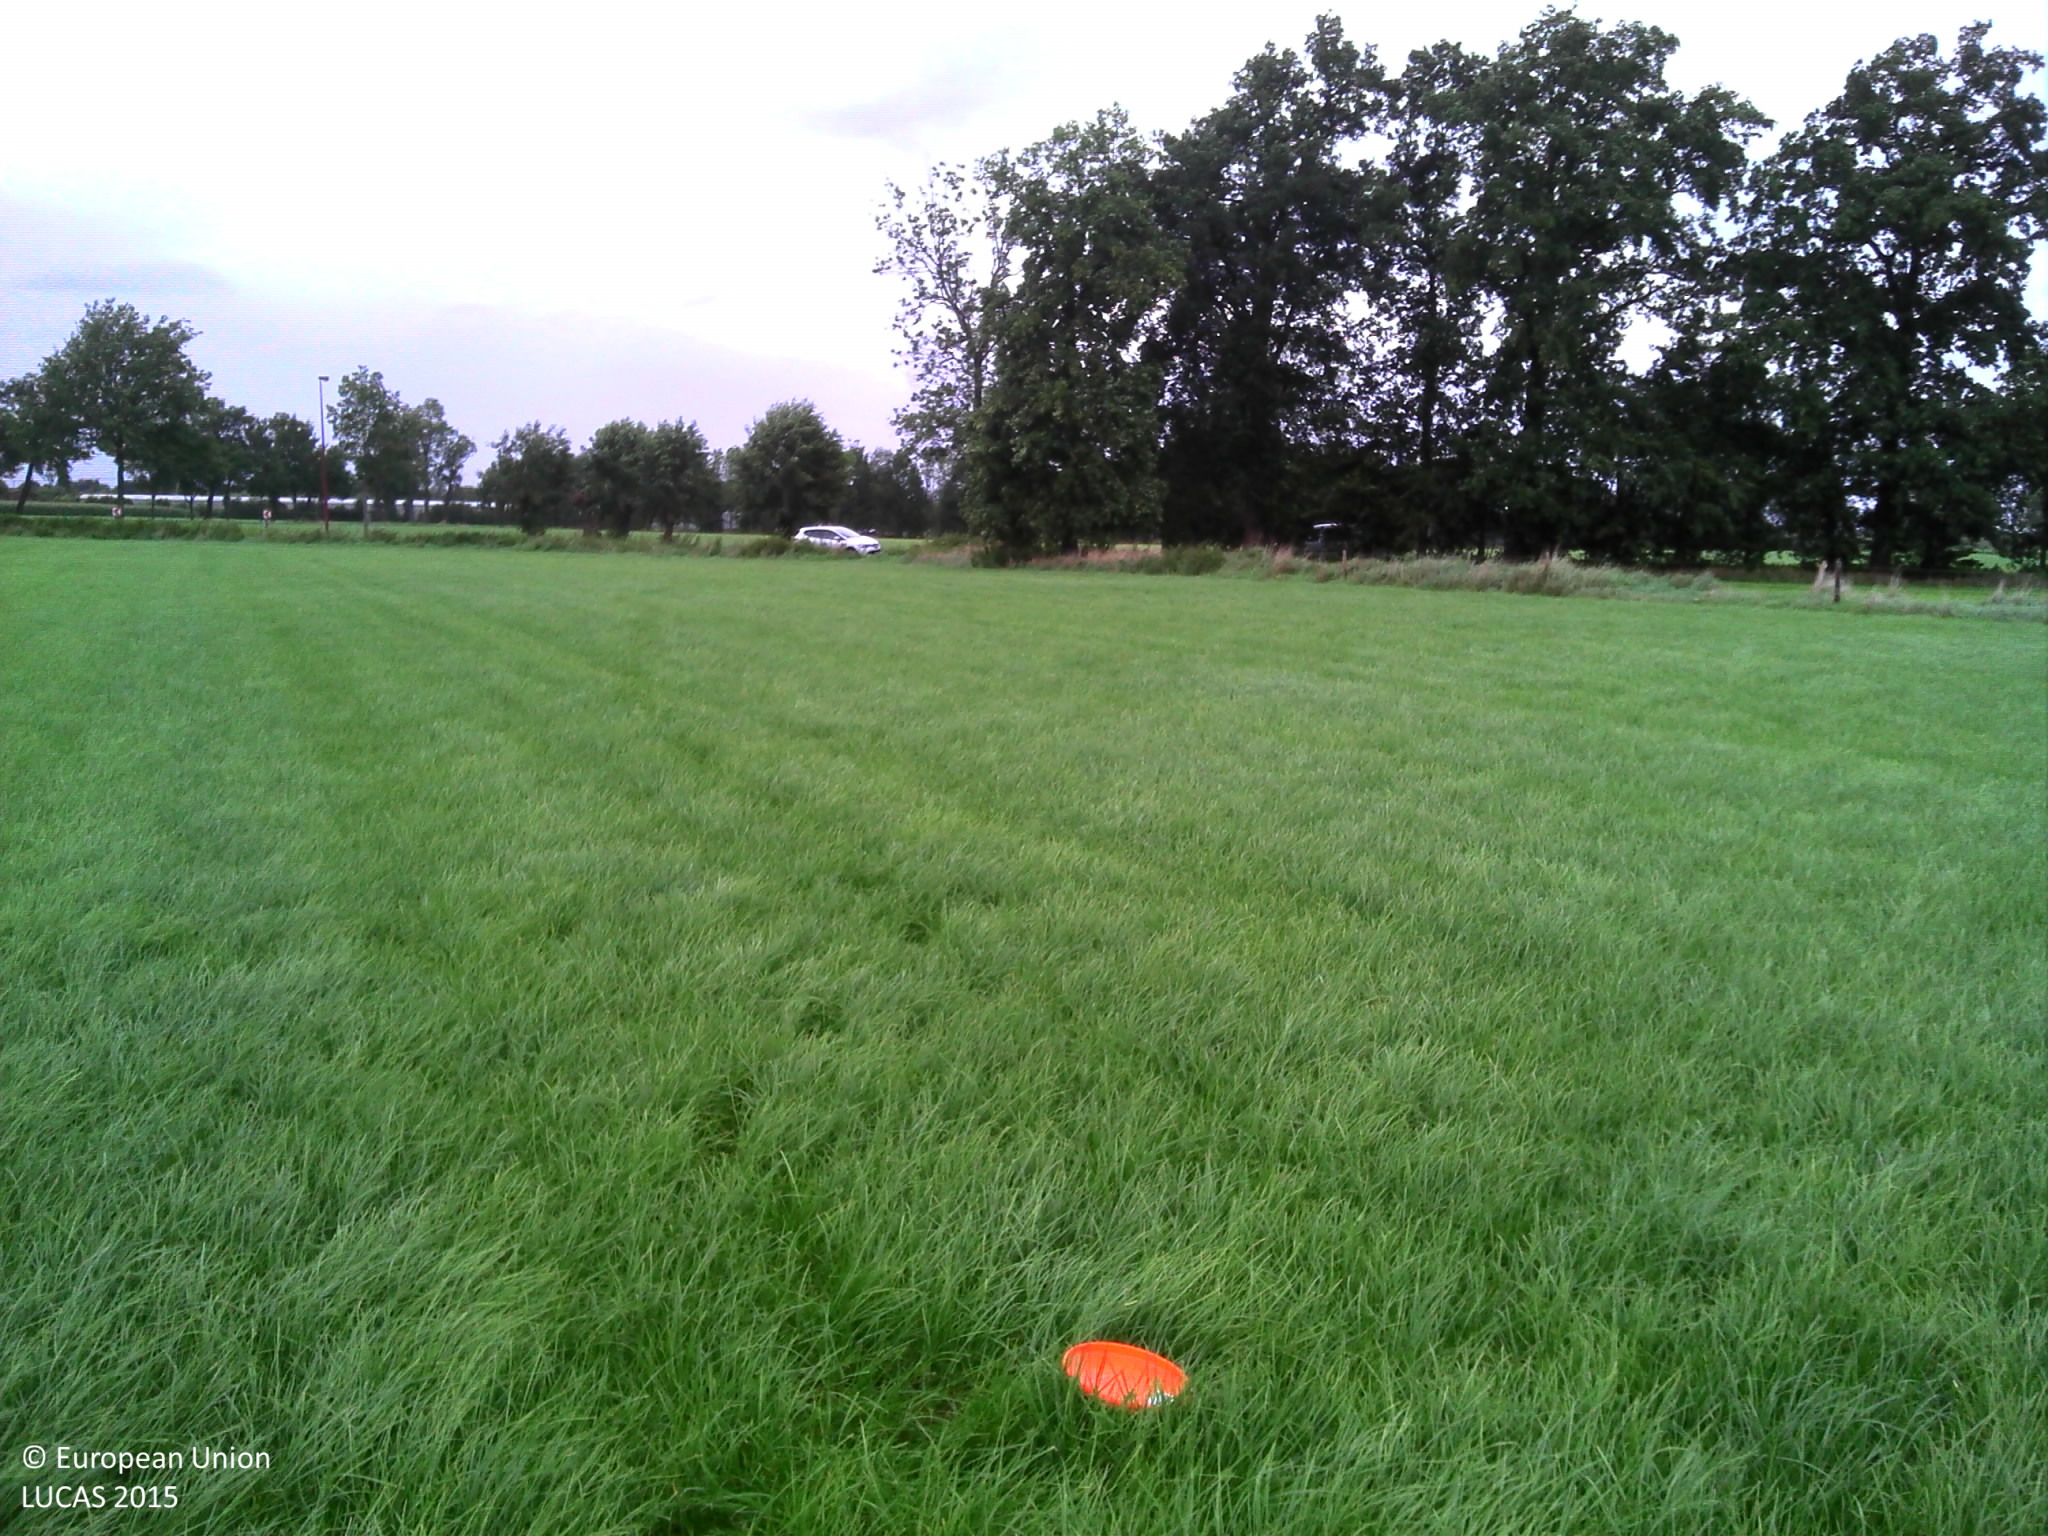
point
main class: Cropland
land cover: Temporary grasslands
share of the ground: > 75 %
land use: Agriculture (excluding fallow land and kitchen gardens)
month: September
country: BE
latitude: 51.3848
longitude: 4.4923
